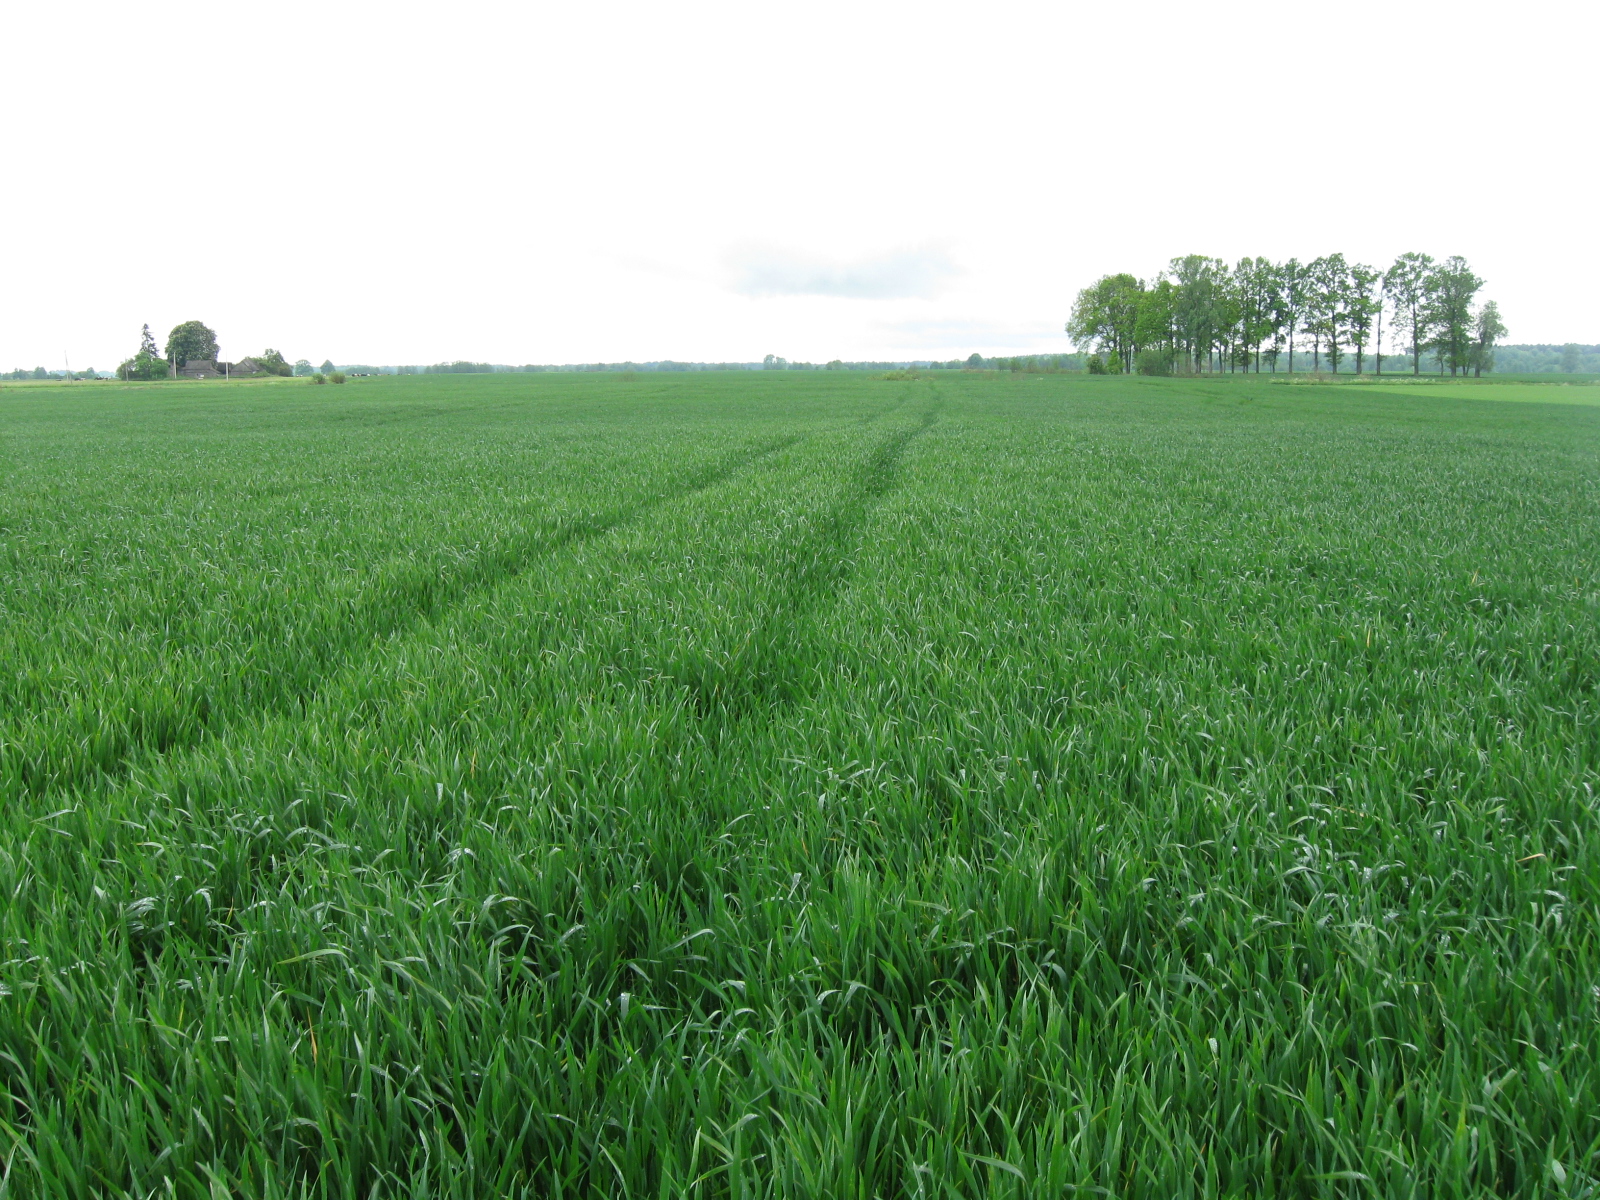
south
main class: Cropland
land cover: Common wheat
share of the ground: > 75 %
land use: Agriculture (excluding fallow land and kitchen gardens)
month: May
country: LT
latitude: 55.0278
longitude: 22.8495
